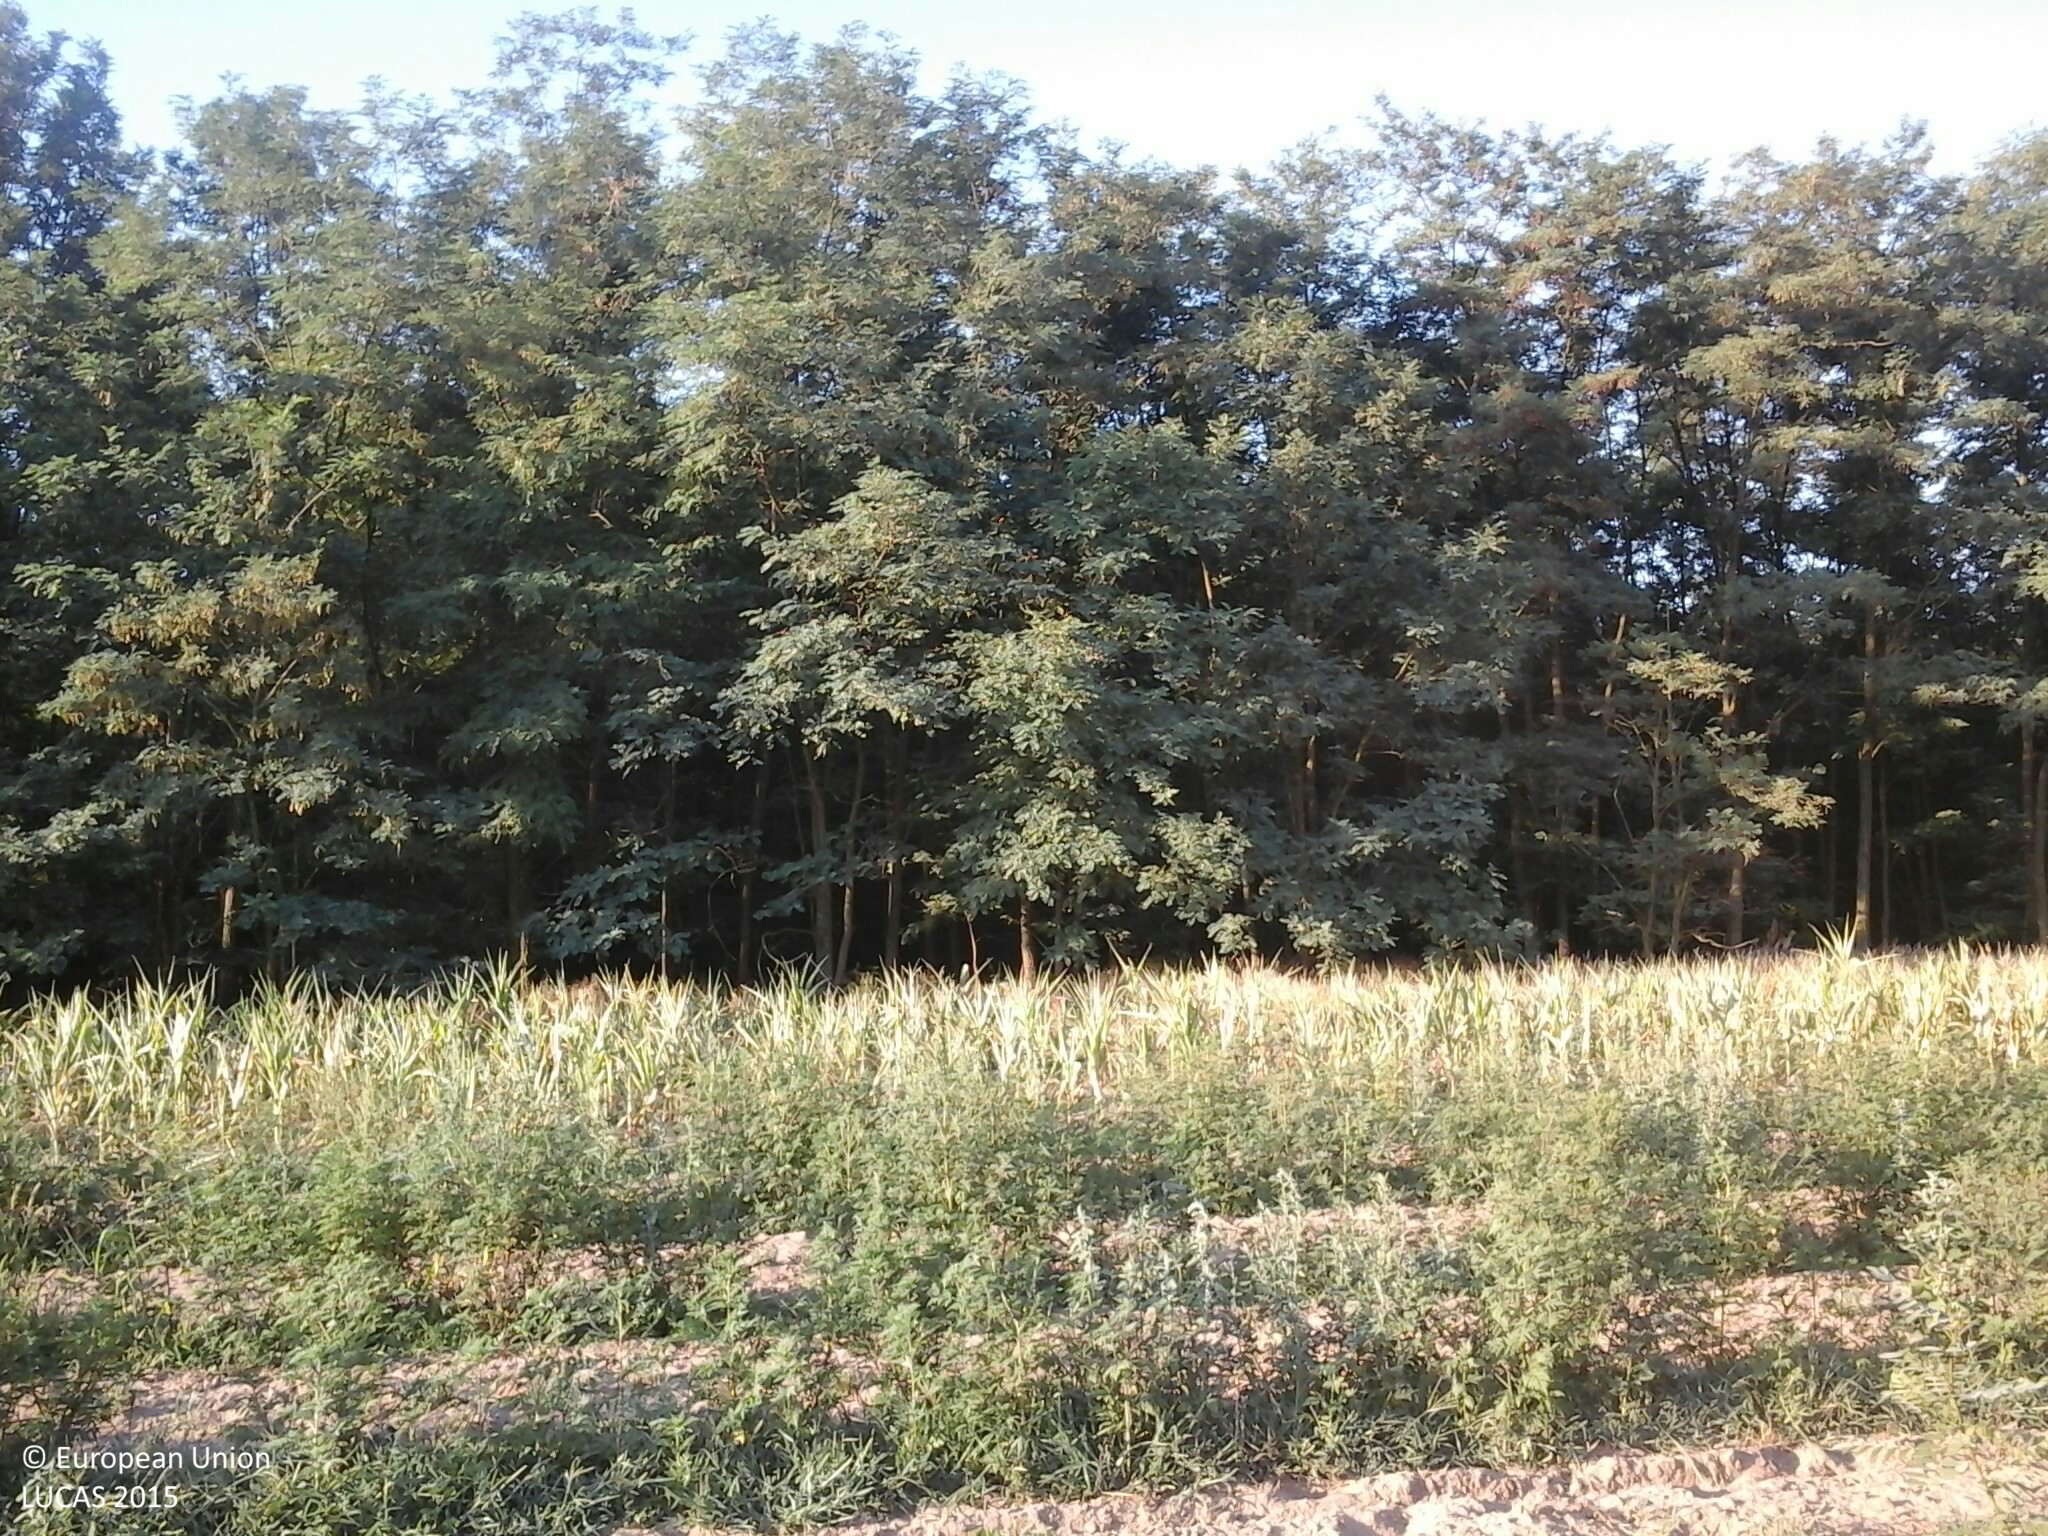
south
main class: Woodland
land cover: Broadleaved woodland
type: exotic forest
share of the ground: 25 - 50 %
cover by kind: unconsolidated bare surface 50 %, broadleaved forest trees 40 %, herbaceous plants 10 %
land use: Forestry
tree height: < 5 m
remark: Nursery
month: July
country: HU
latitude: 47.6985
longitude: 22.1116
